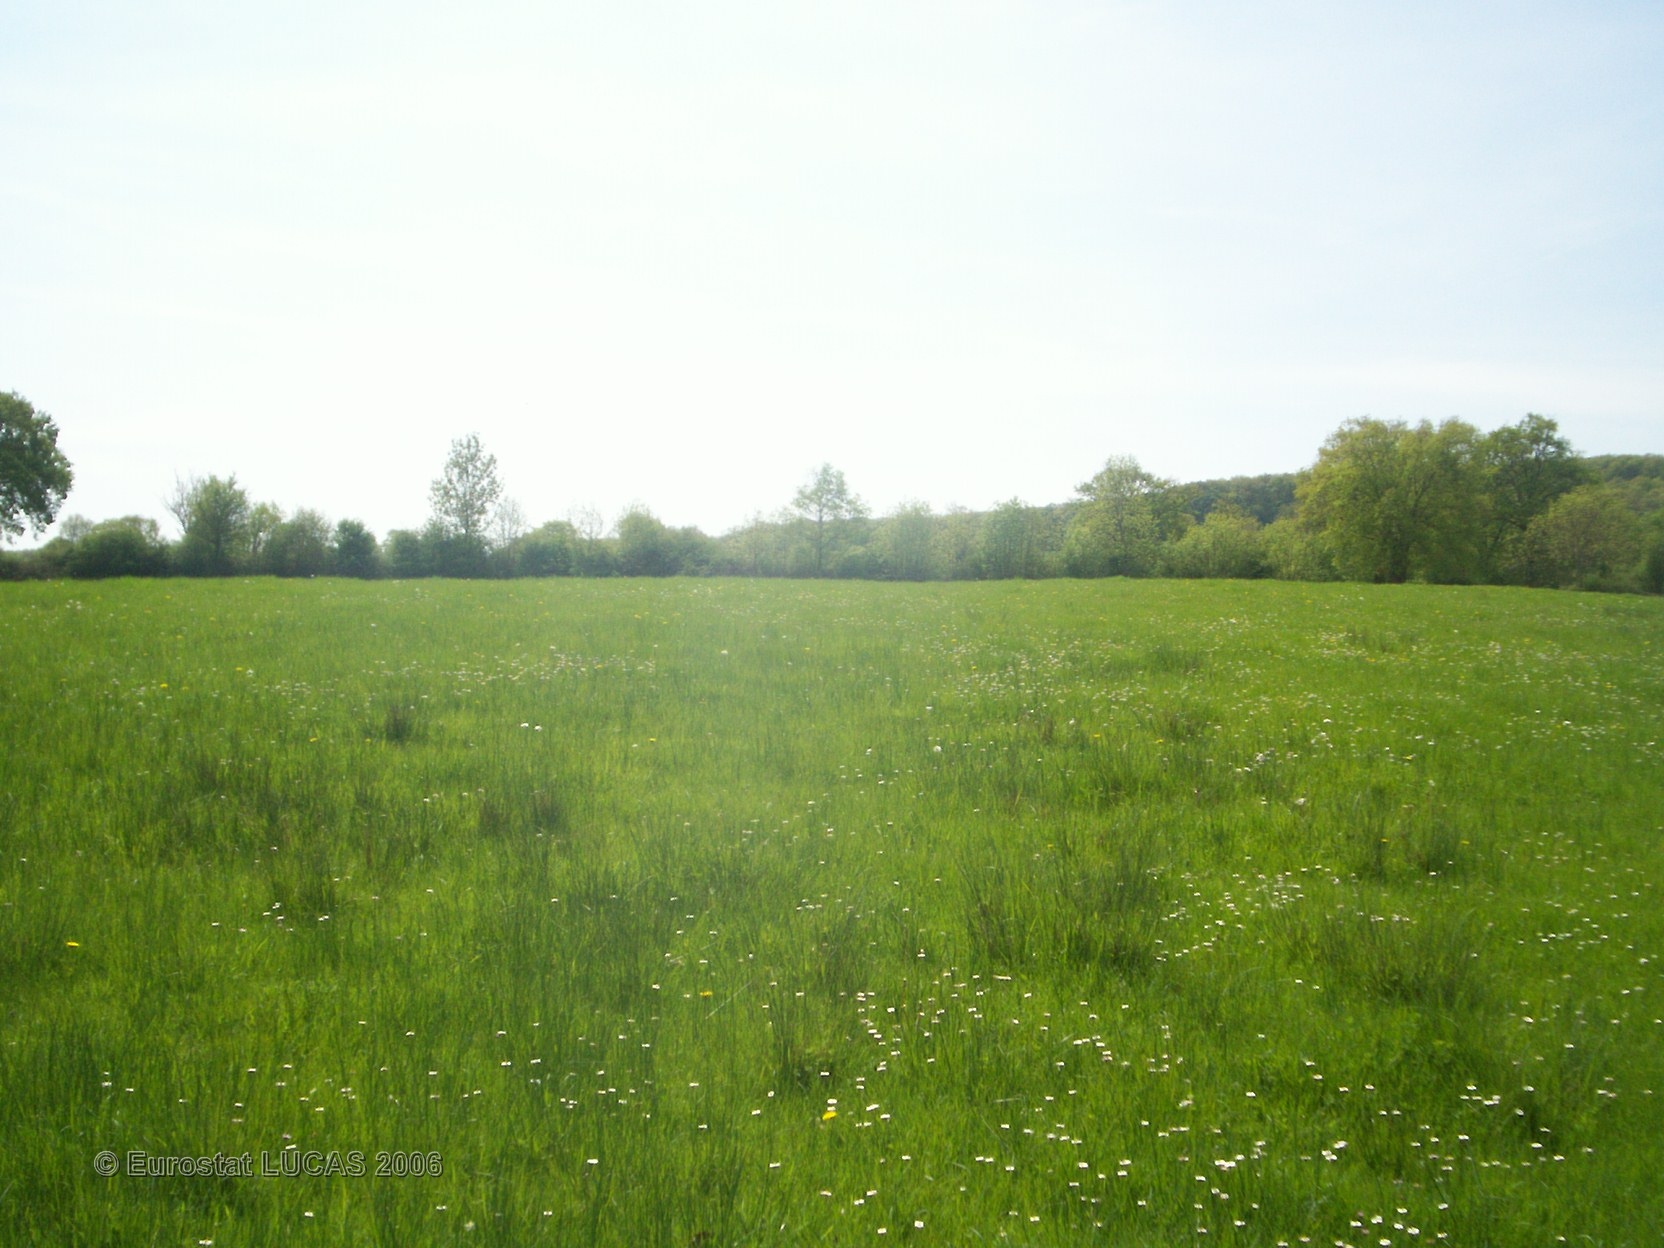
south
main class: Grassland
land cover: Grassland with sparse tree/shrub cover
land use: Agriculture (excluding fallow land and kitchen gardens)
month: May
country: FR
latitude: 46.5276
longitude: 3.1271
